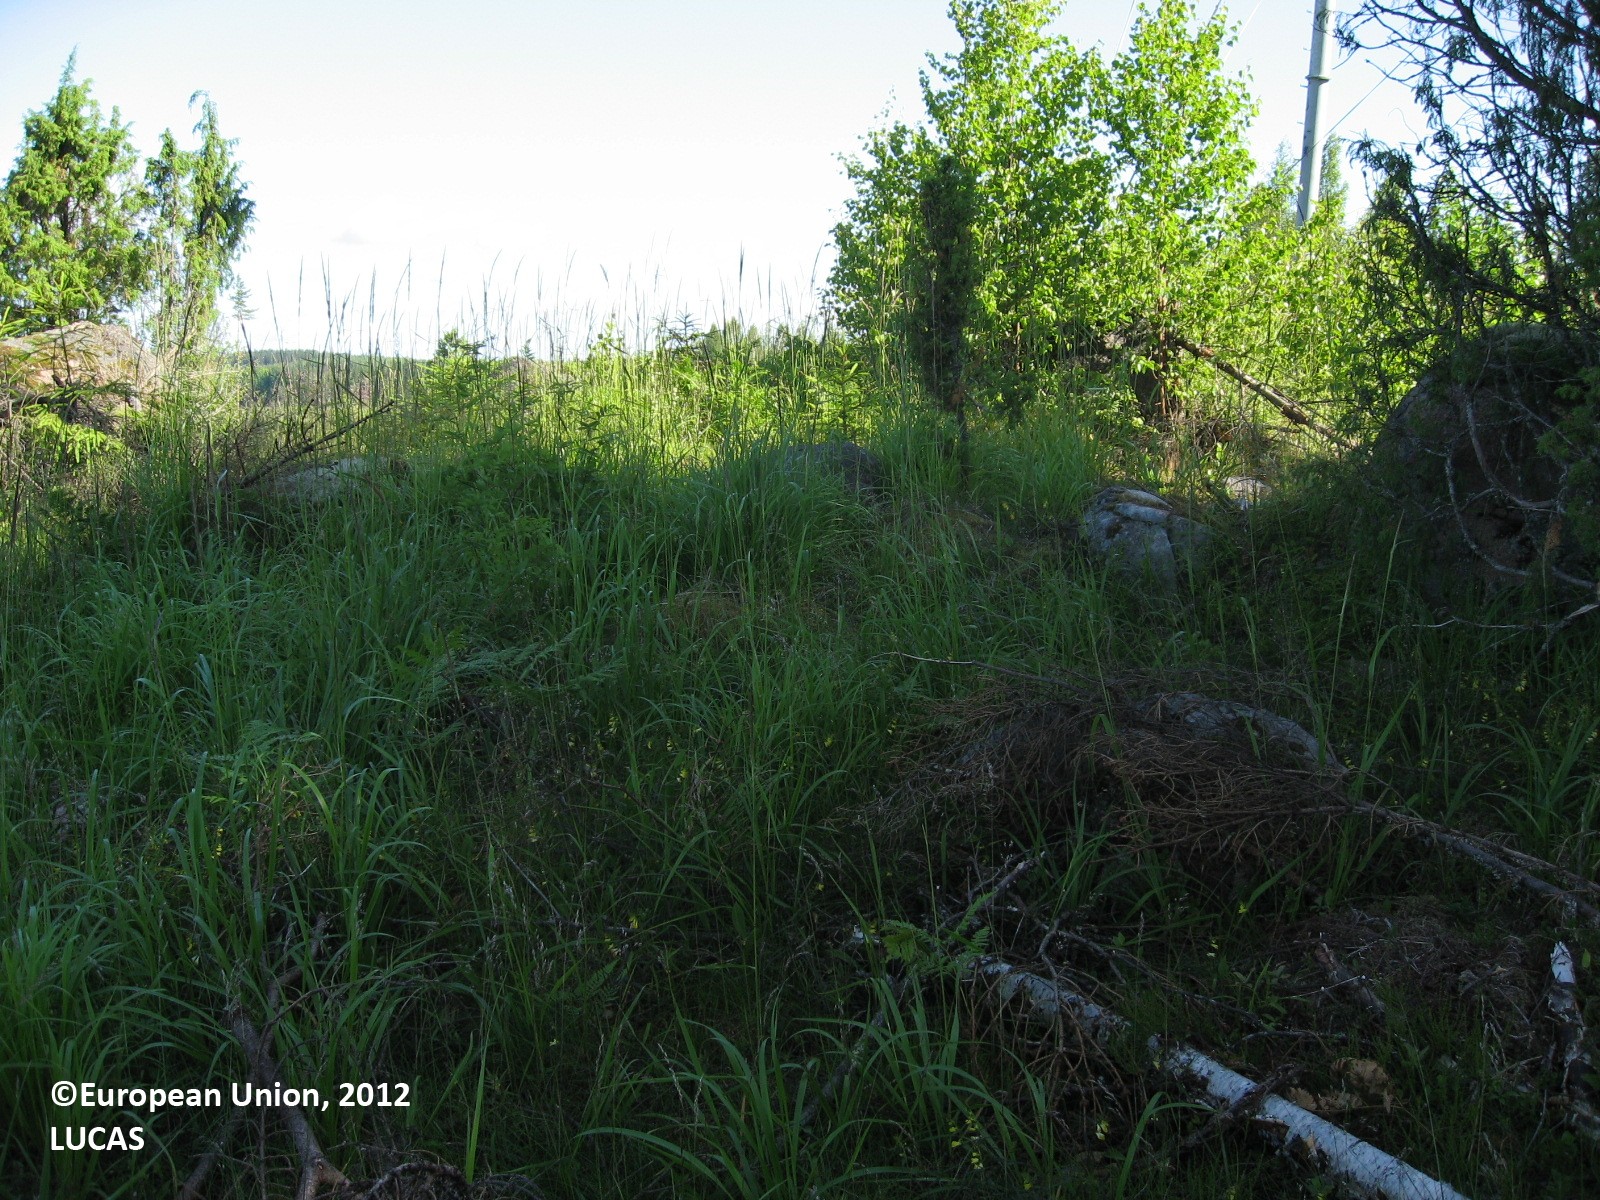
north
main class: Grassland
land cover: Grassland with sparse tree/shrub cover
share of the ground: 50 - 75 %
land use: Forestry
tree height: < 5 m
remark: Clear cut
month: July
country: FI
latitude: 60.8129
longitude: 26.2688
